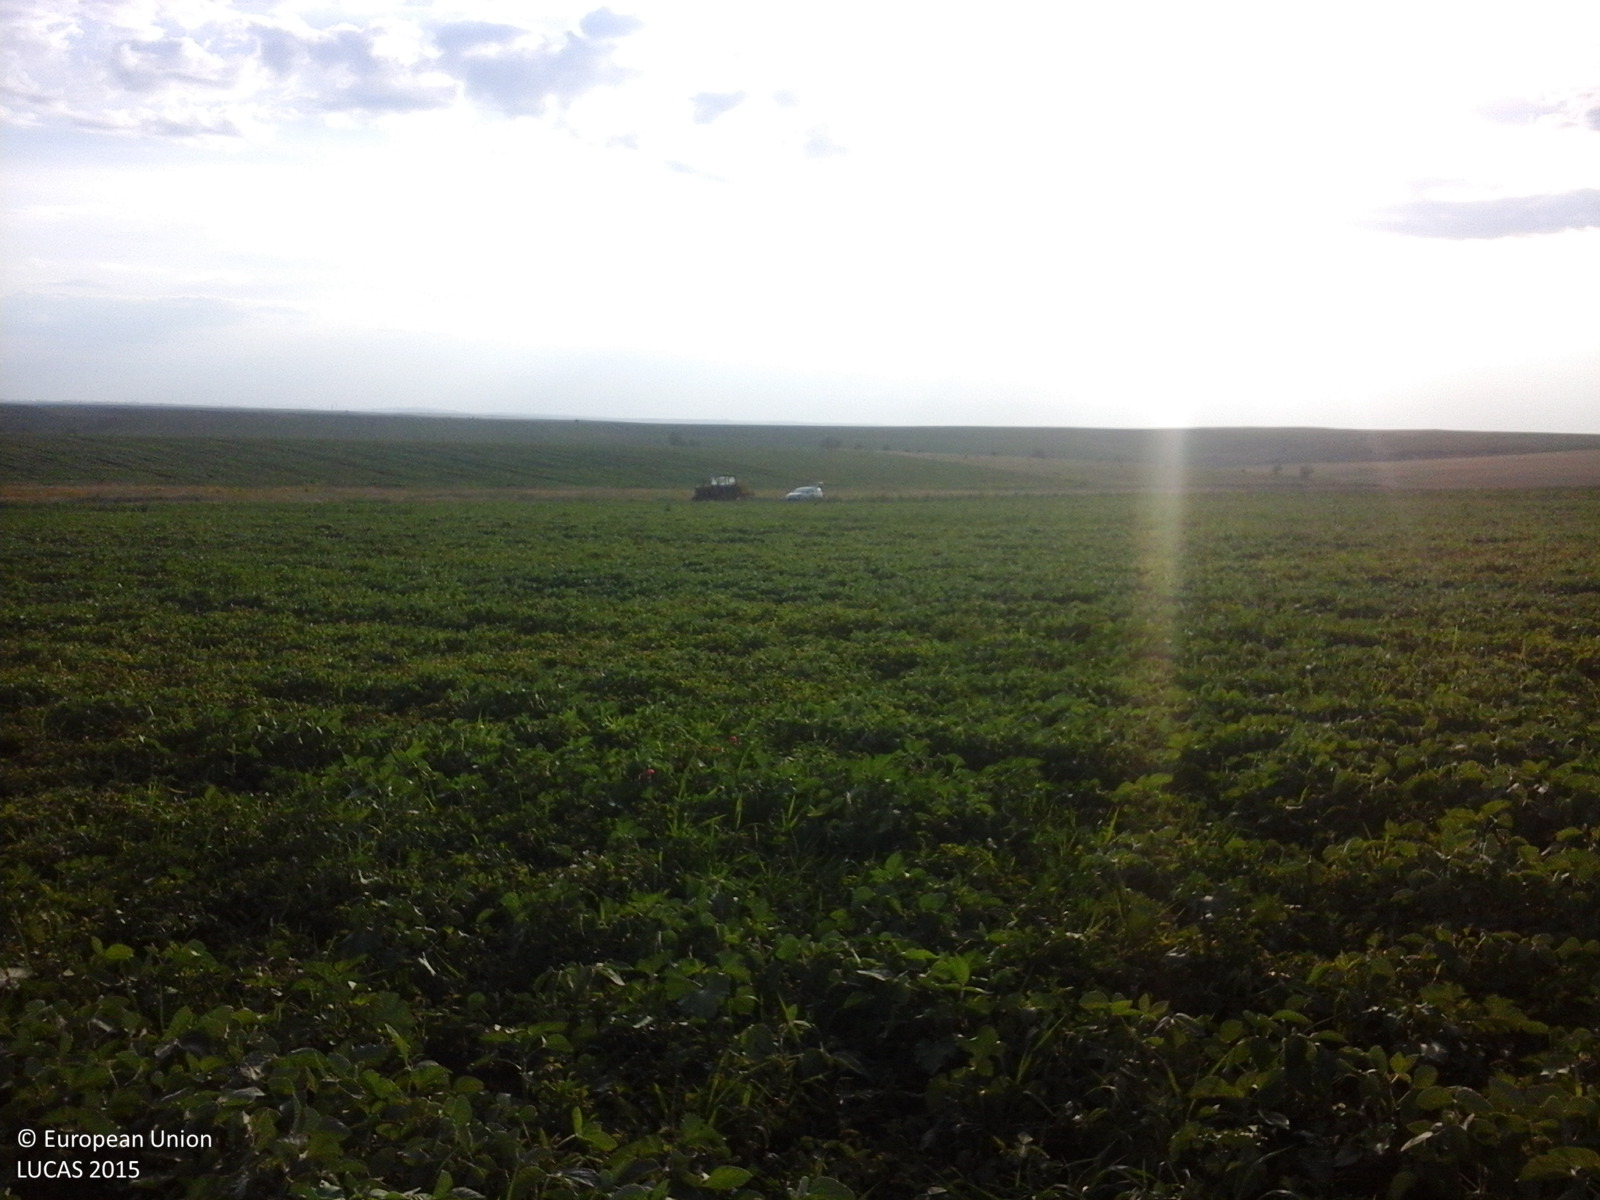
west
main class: Cropland
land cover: Soya
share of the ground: > 75 %
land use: Agriculture (excluding fallow land and kitchen gardens)
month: June
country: RO
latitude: 48.1033
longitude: 26.7660
